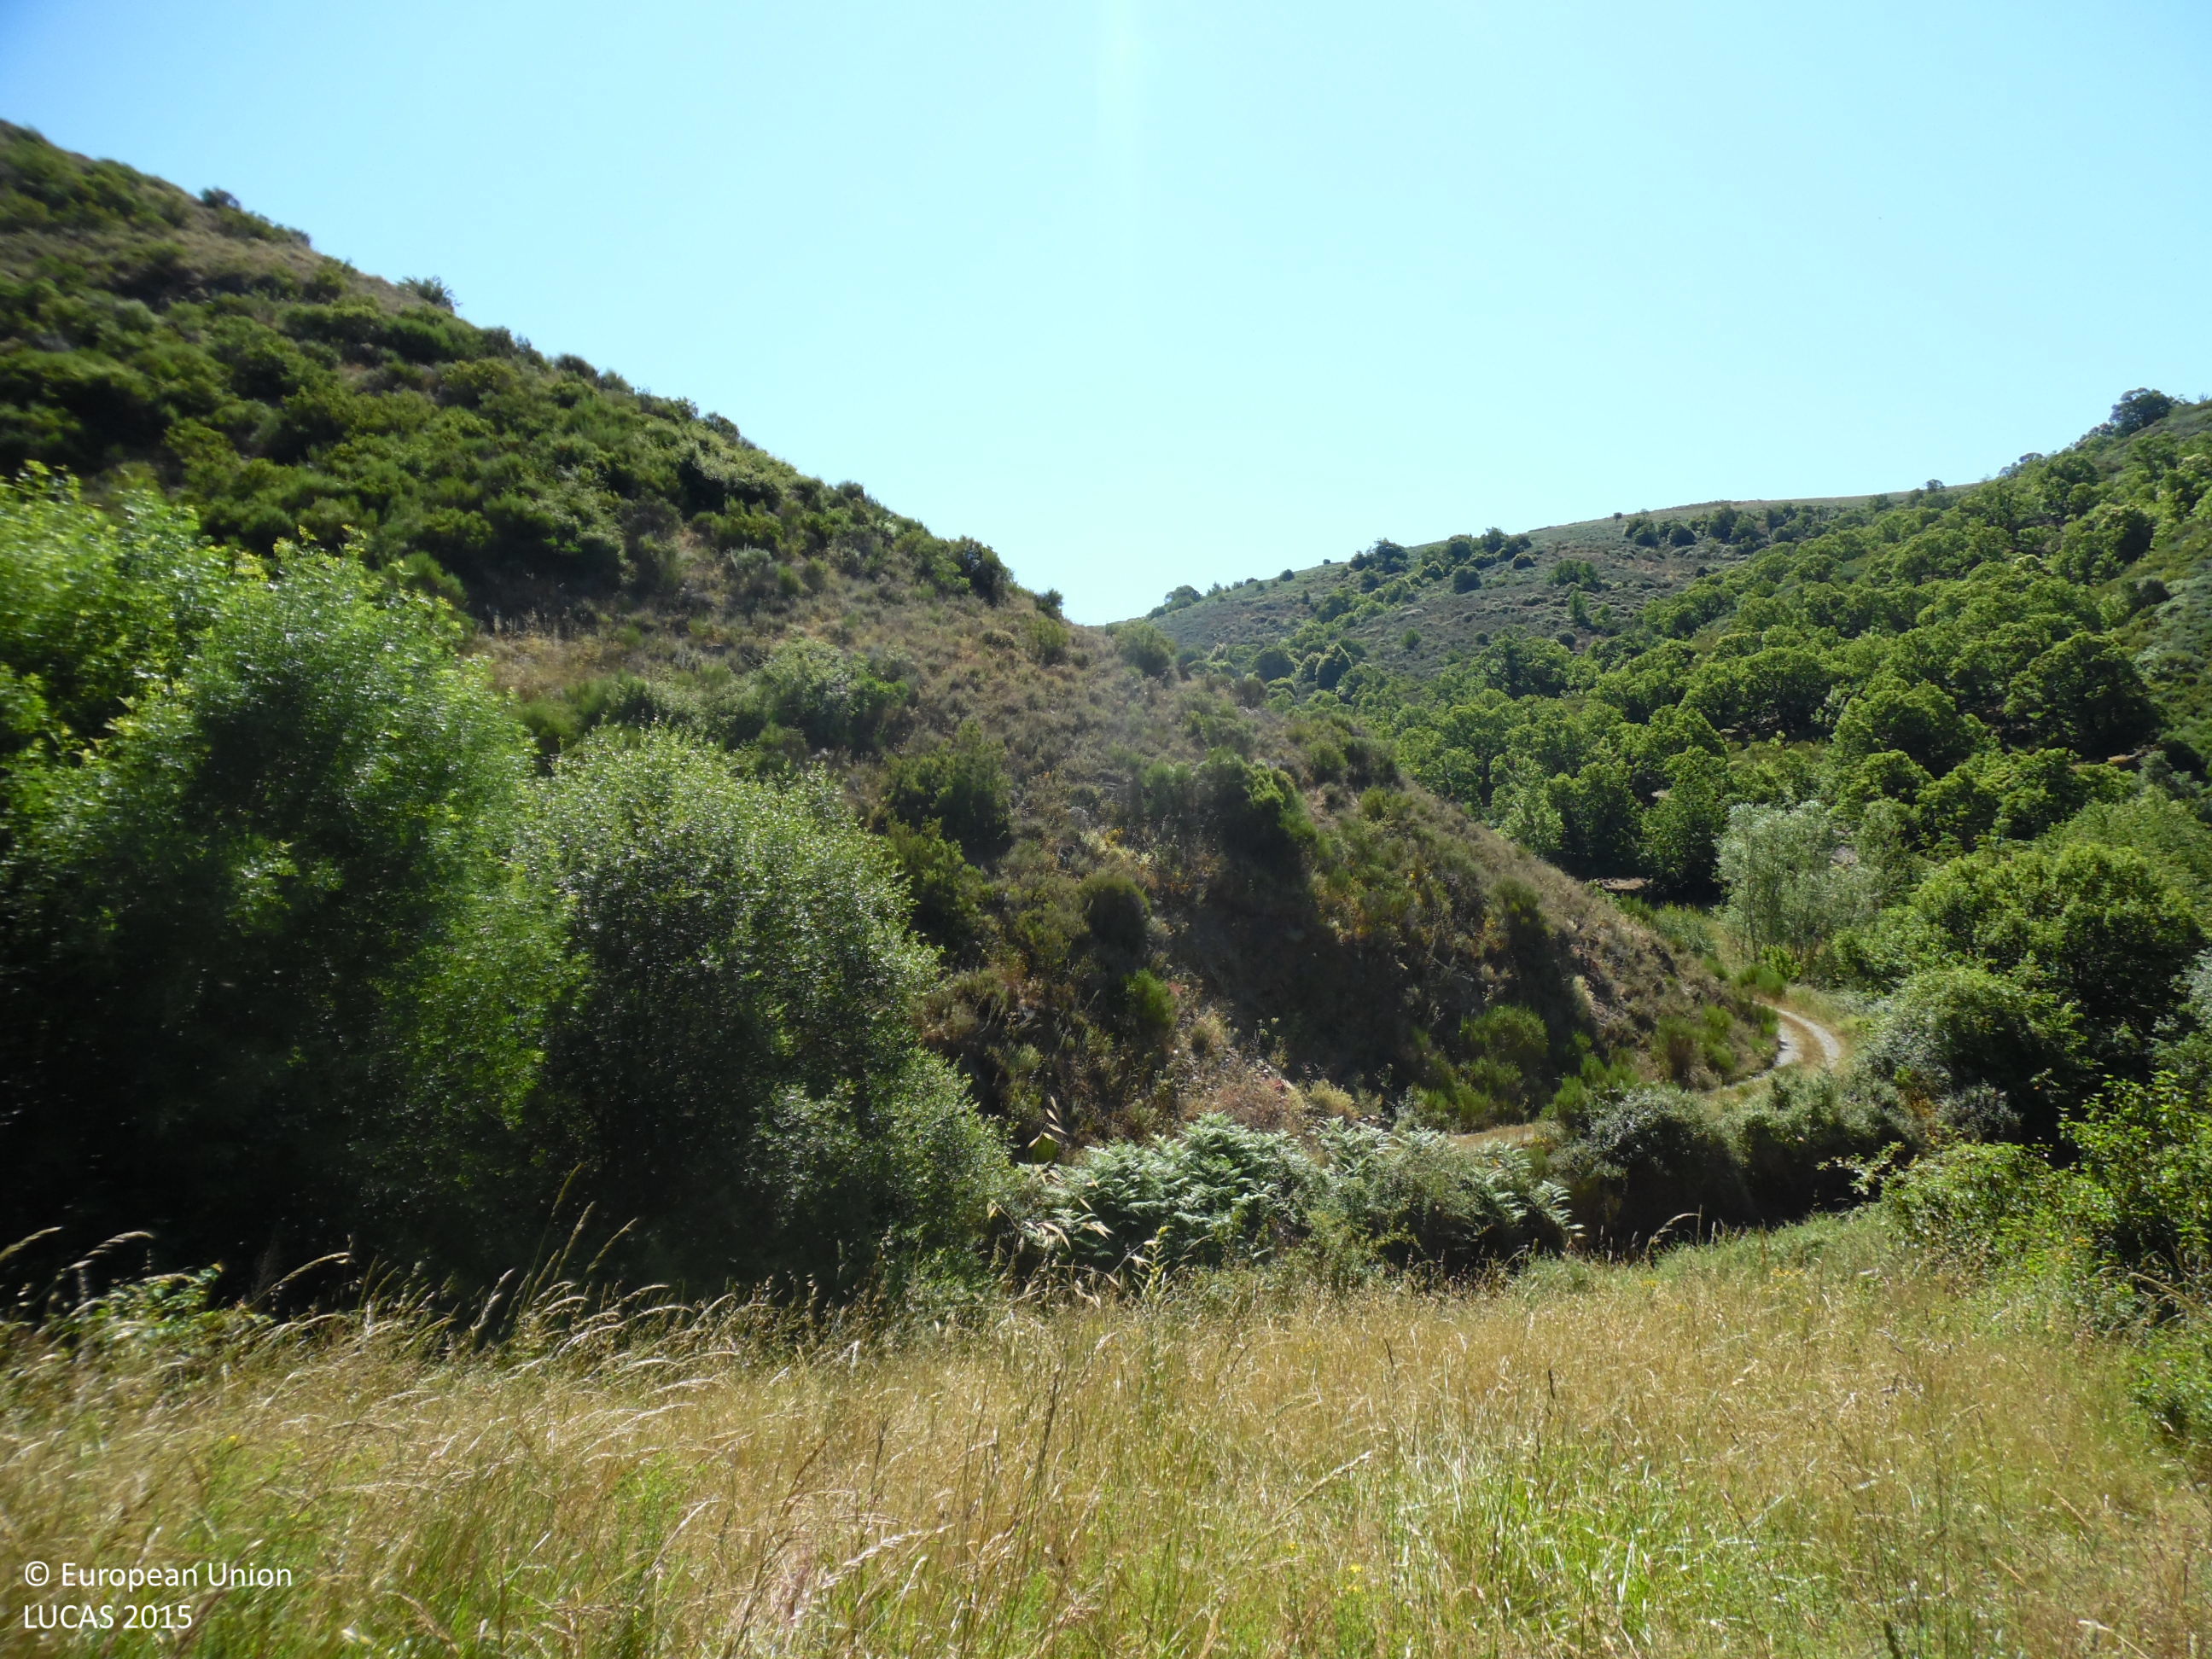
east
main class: Grassland
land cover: Grassland without tree/shrub cover
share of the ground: 50 - 75 %
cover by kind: herbaceous plants 95 %, shrubs 5 %
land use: Agriculture (excluding fallow land and kitchen gardens)
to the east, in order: Grassland without tree/shrub cover; Abandoned hedges; Rivers and streams; Tracks; Shrubland without tree cover; Shrubland with sparse tree cover; Shrubland without tree cover; Shrubland with sparse tree cover; Broadleaved woodland; Tracks; Broadleaved woodland; Tracks; Broadleaved woodland
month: June
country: ES
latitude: 42.5695
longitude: -6.8771
